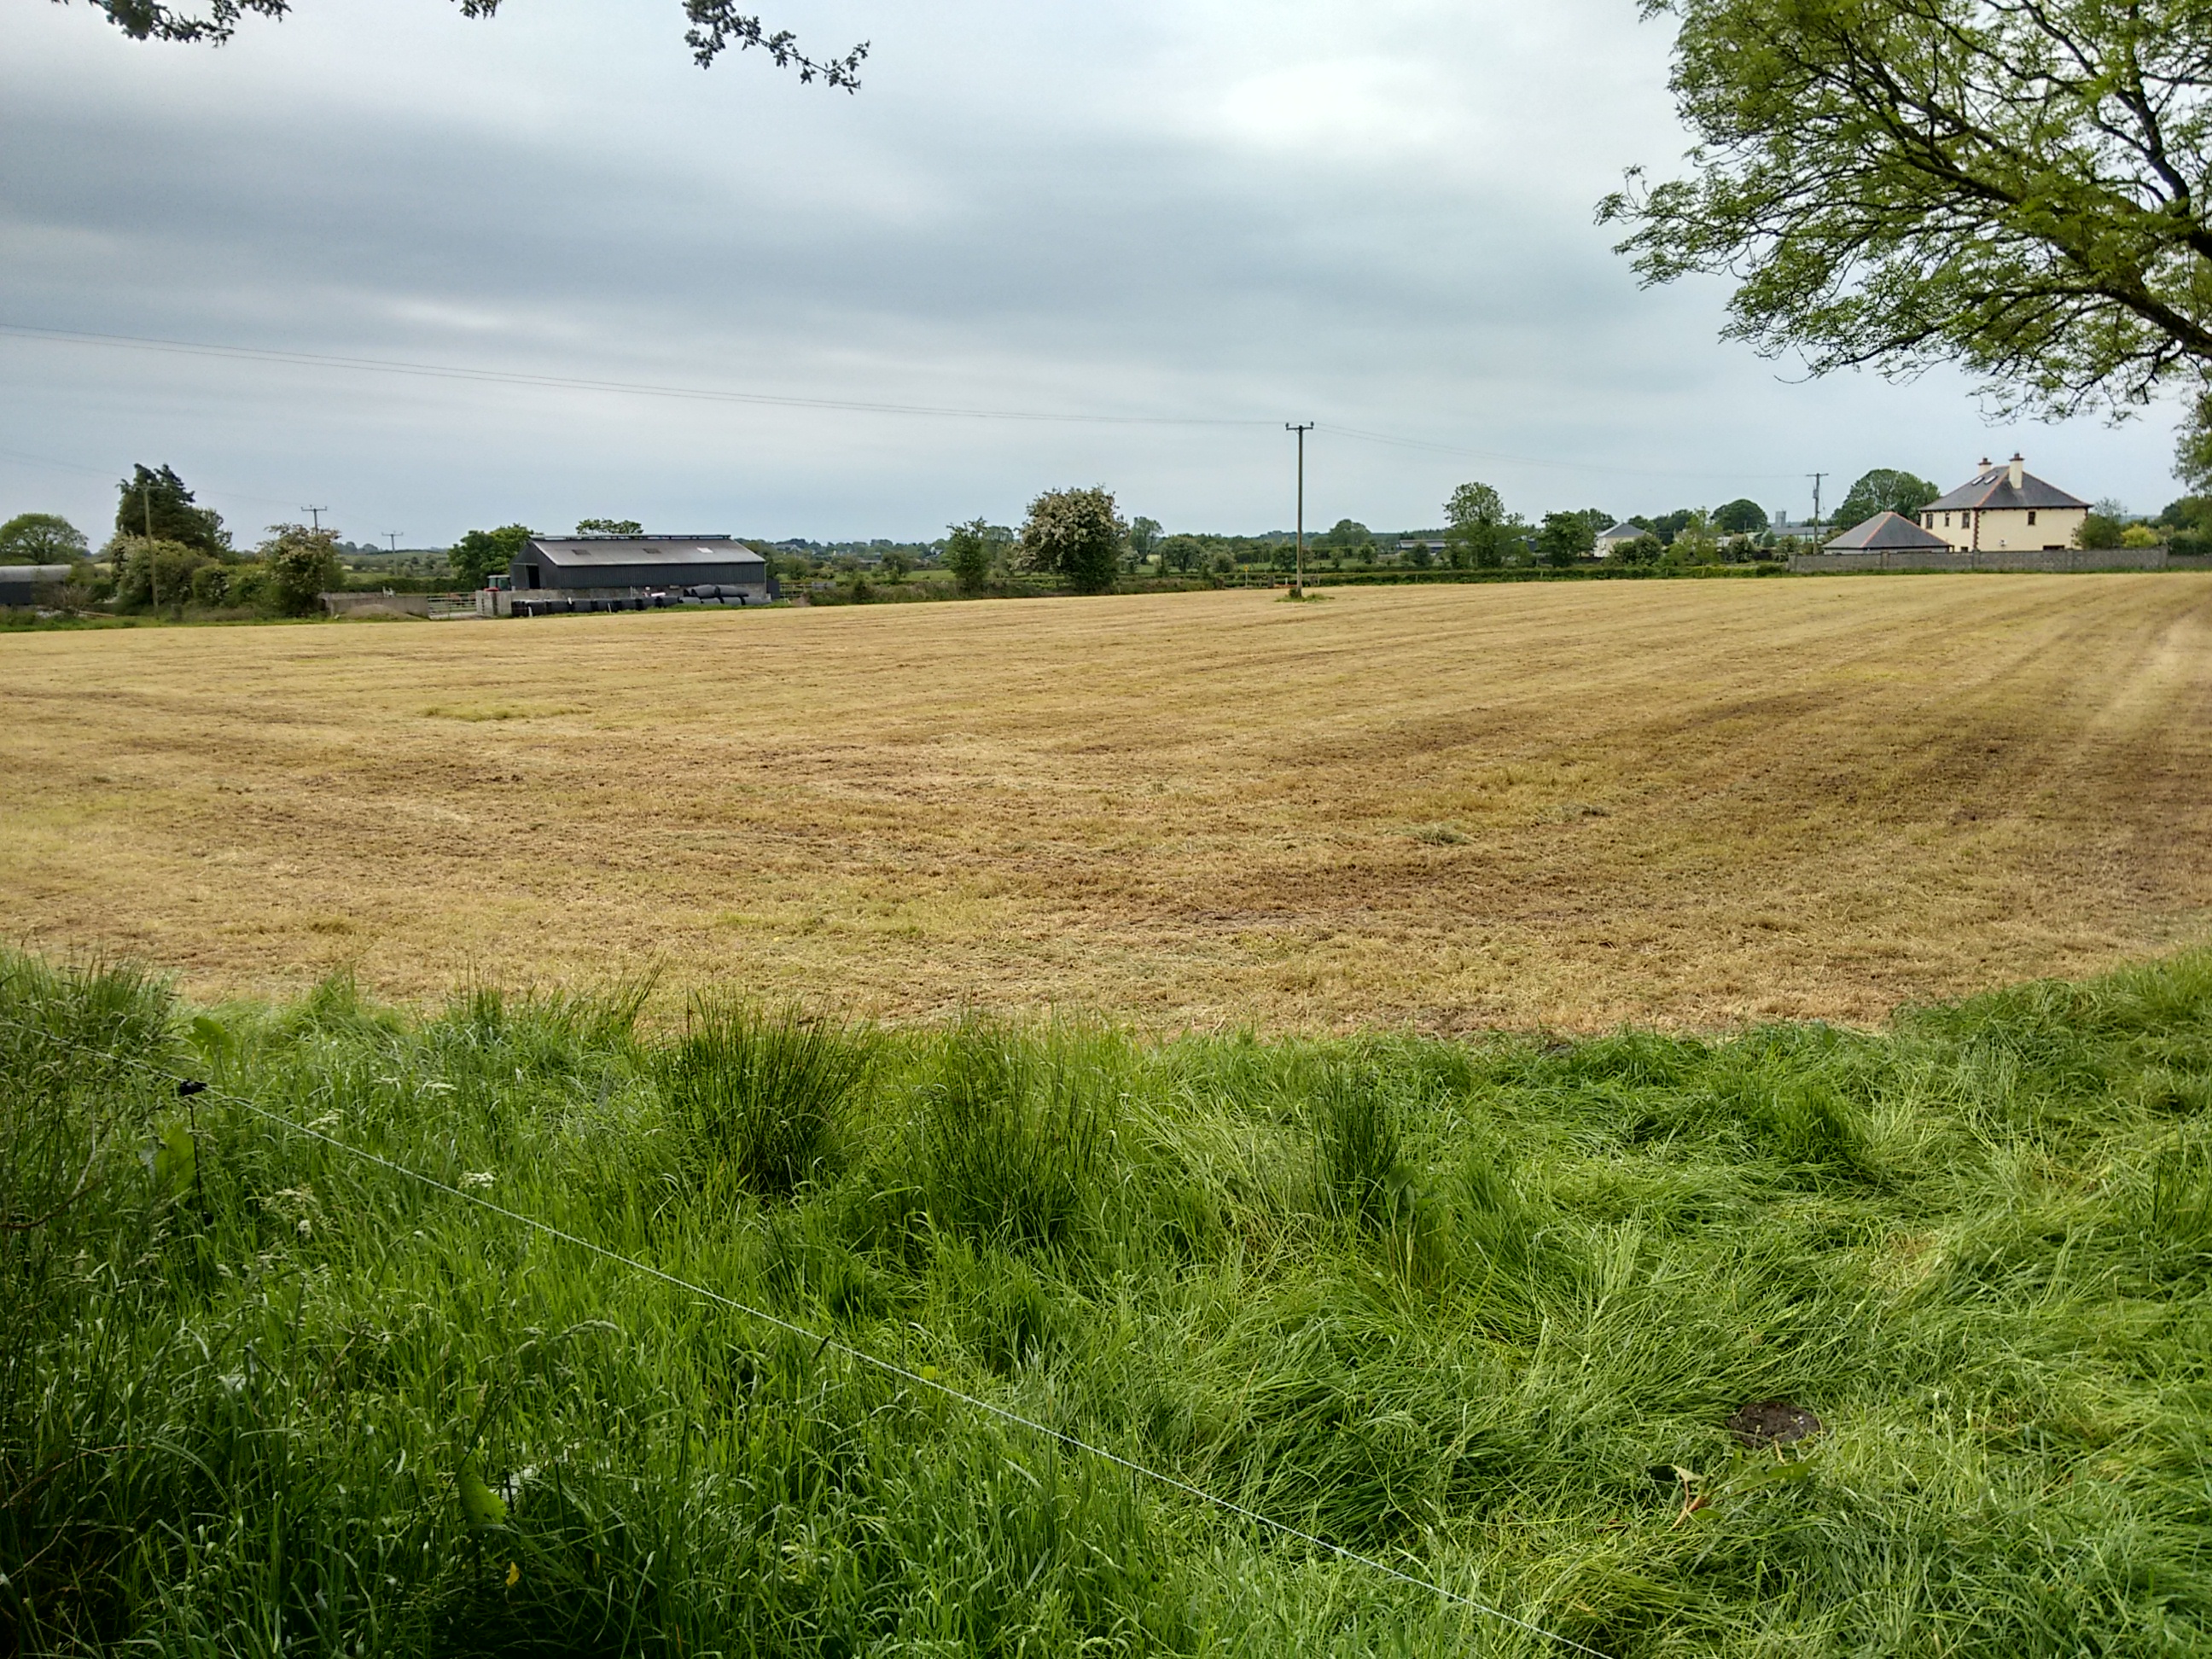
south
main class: Grassland
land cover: Grassland without tree/shrub cover
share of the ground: > 75 %
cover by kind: herbaceous plants 100 %
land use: Agriculture (excluding fallow land and kitchen gardens)
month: June
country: IE
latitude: 53.4333
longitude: -8.6369
